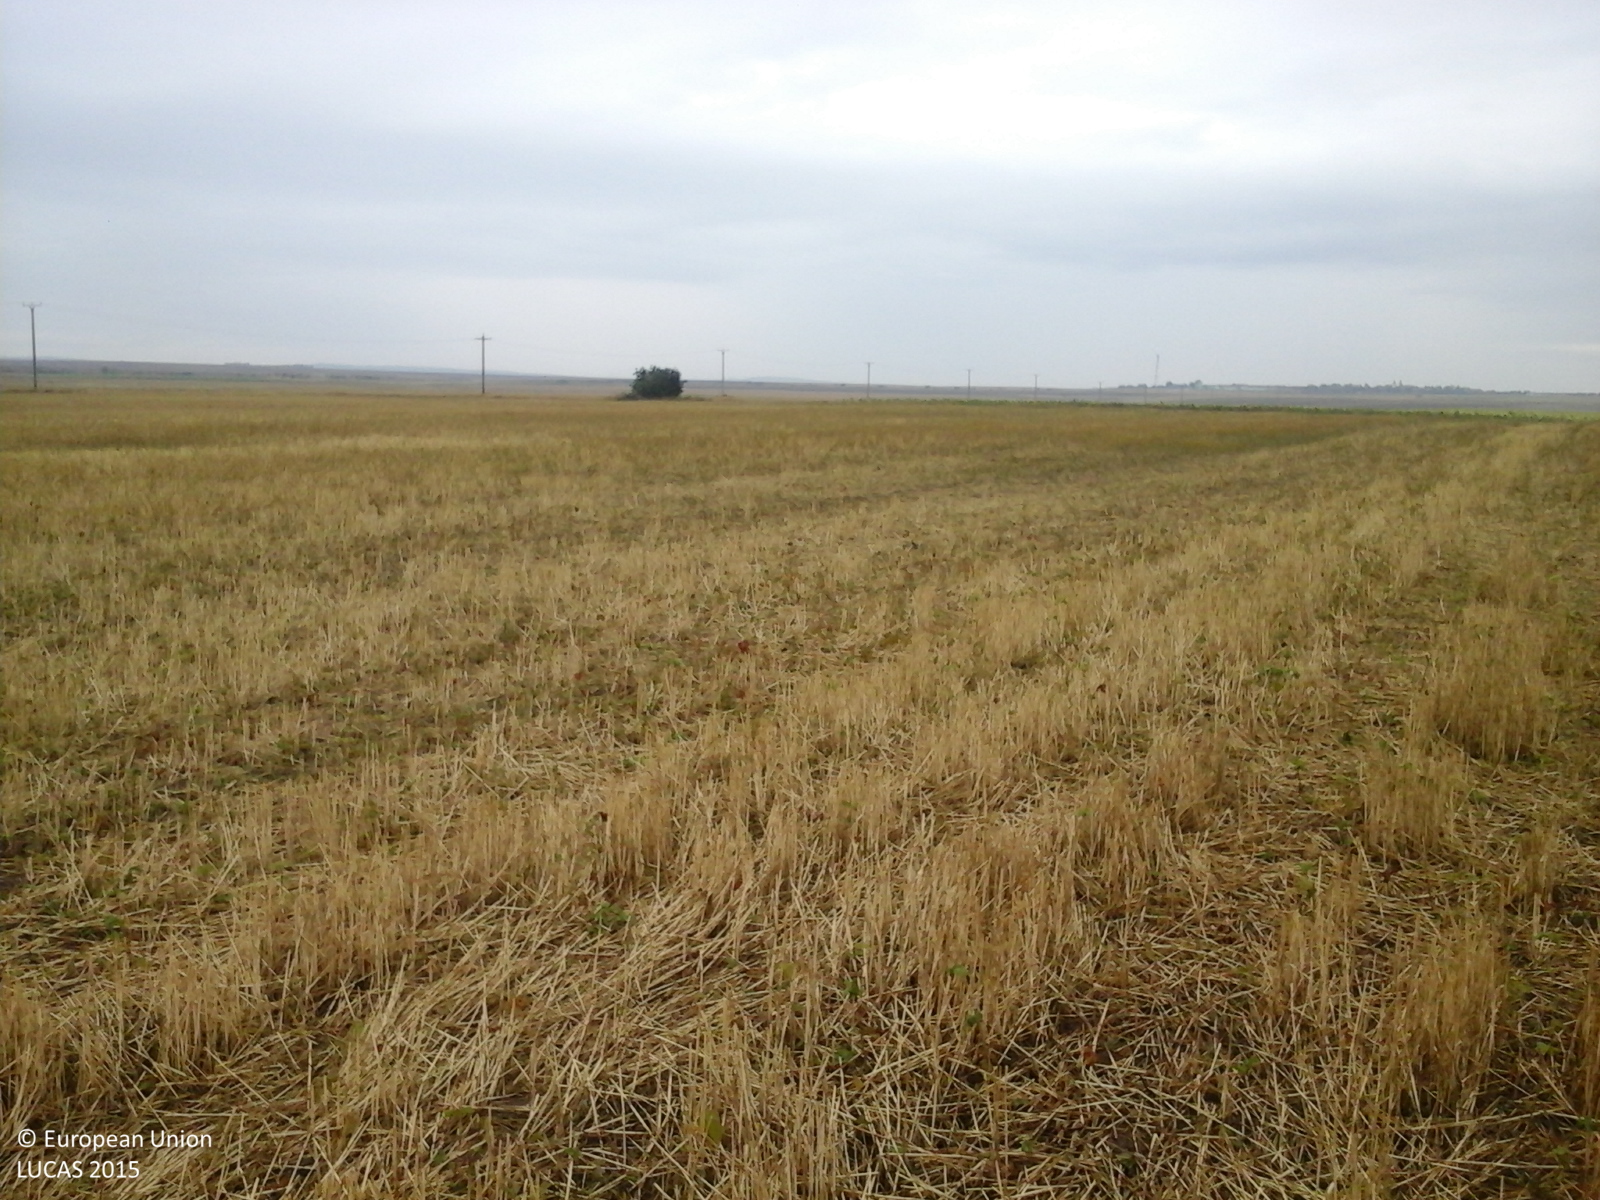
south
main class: Cropland
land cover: Common wheat
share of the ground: > 75 %
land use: Agriculture (excluding fallow land and kitchen gardens)
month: August
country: RO
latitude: 46.0232
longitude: 21.4671
